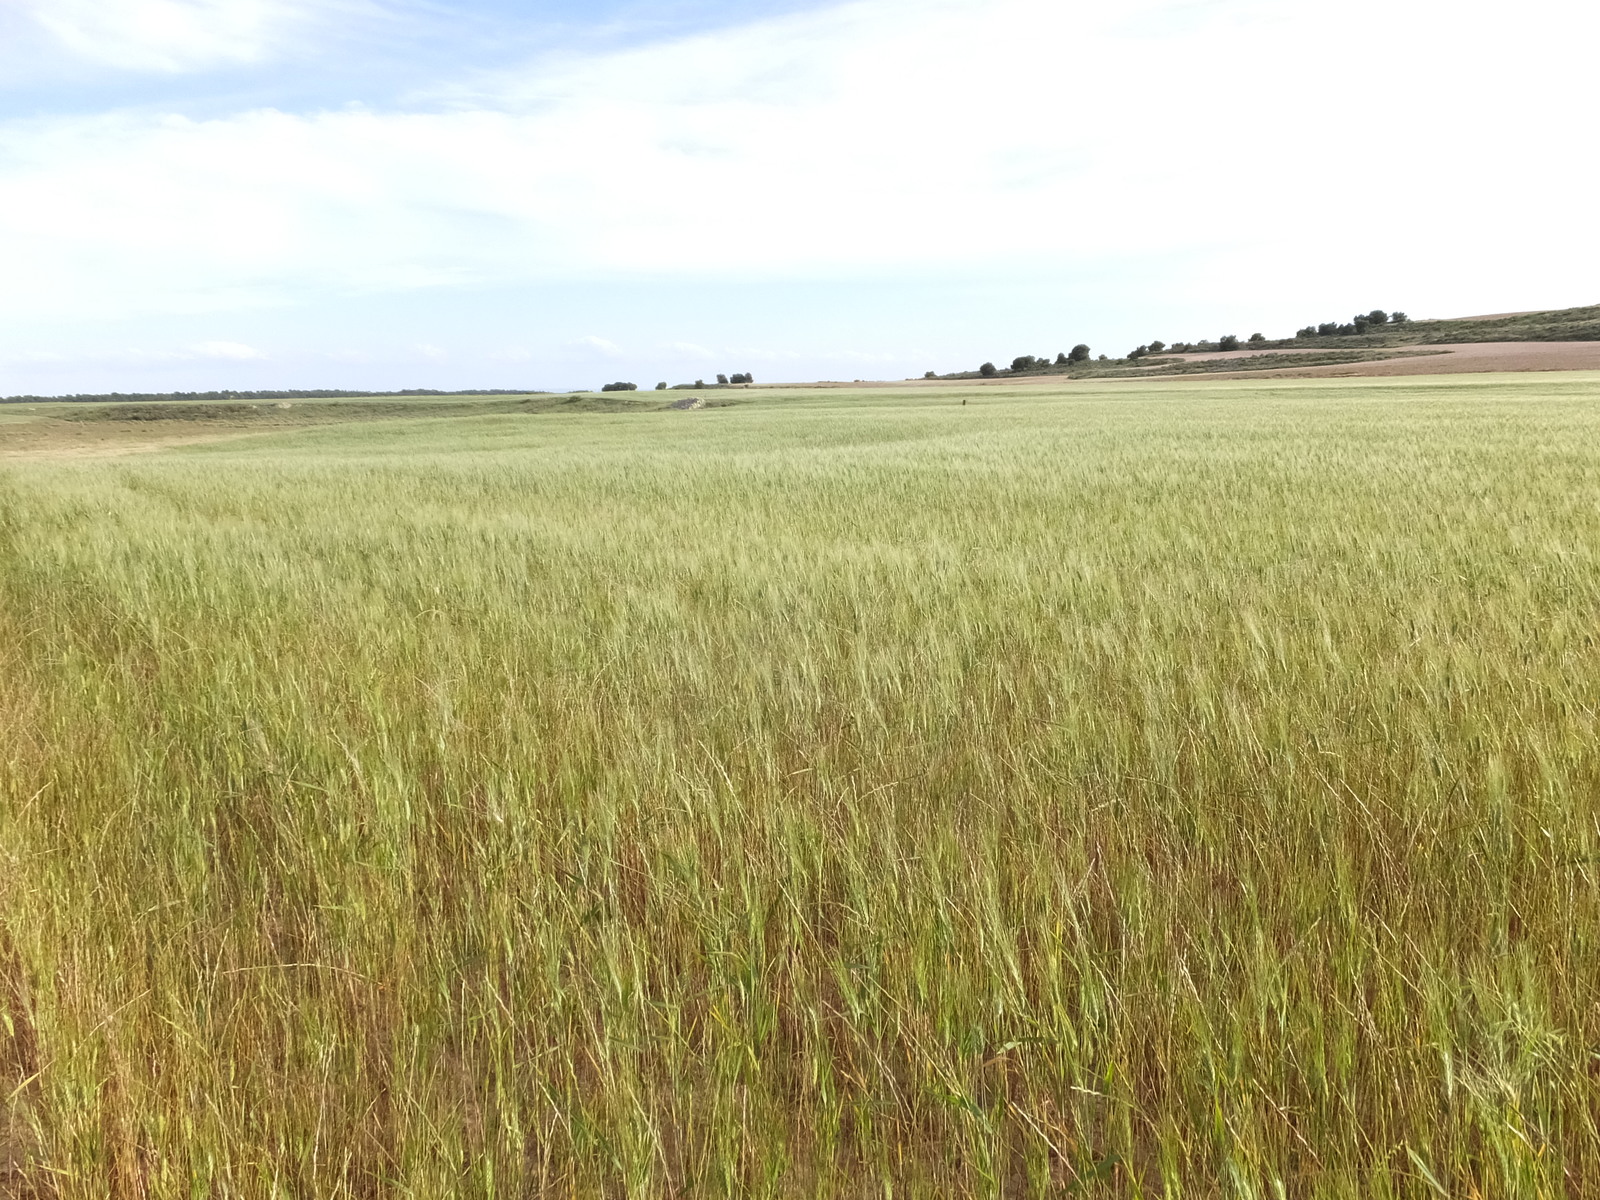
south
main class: Cropland
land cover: Durum wheat
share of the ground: > 75 %
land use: Agriculture (excluding fallow land and kitchen gardens)
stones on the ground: < 10 %
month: May
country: ES
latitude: 41.3698
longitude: -0.2368
